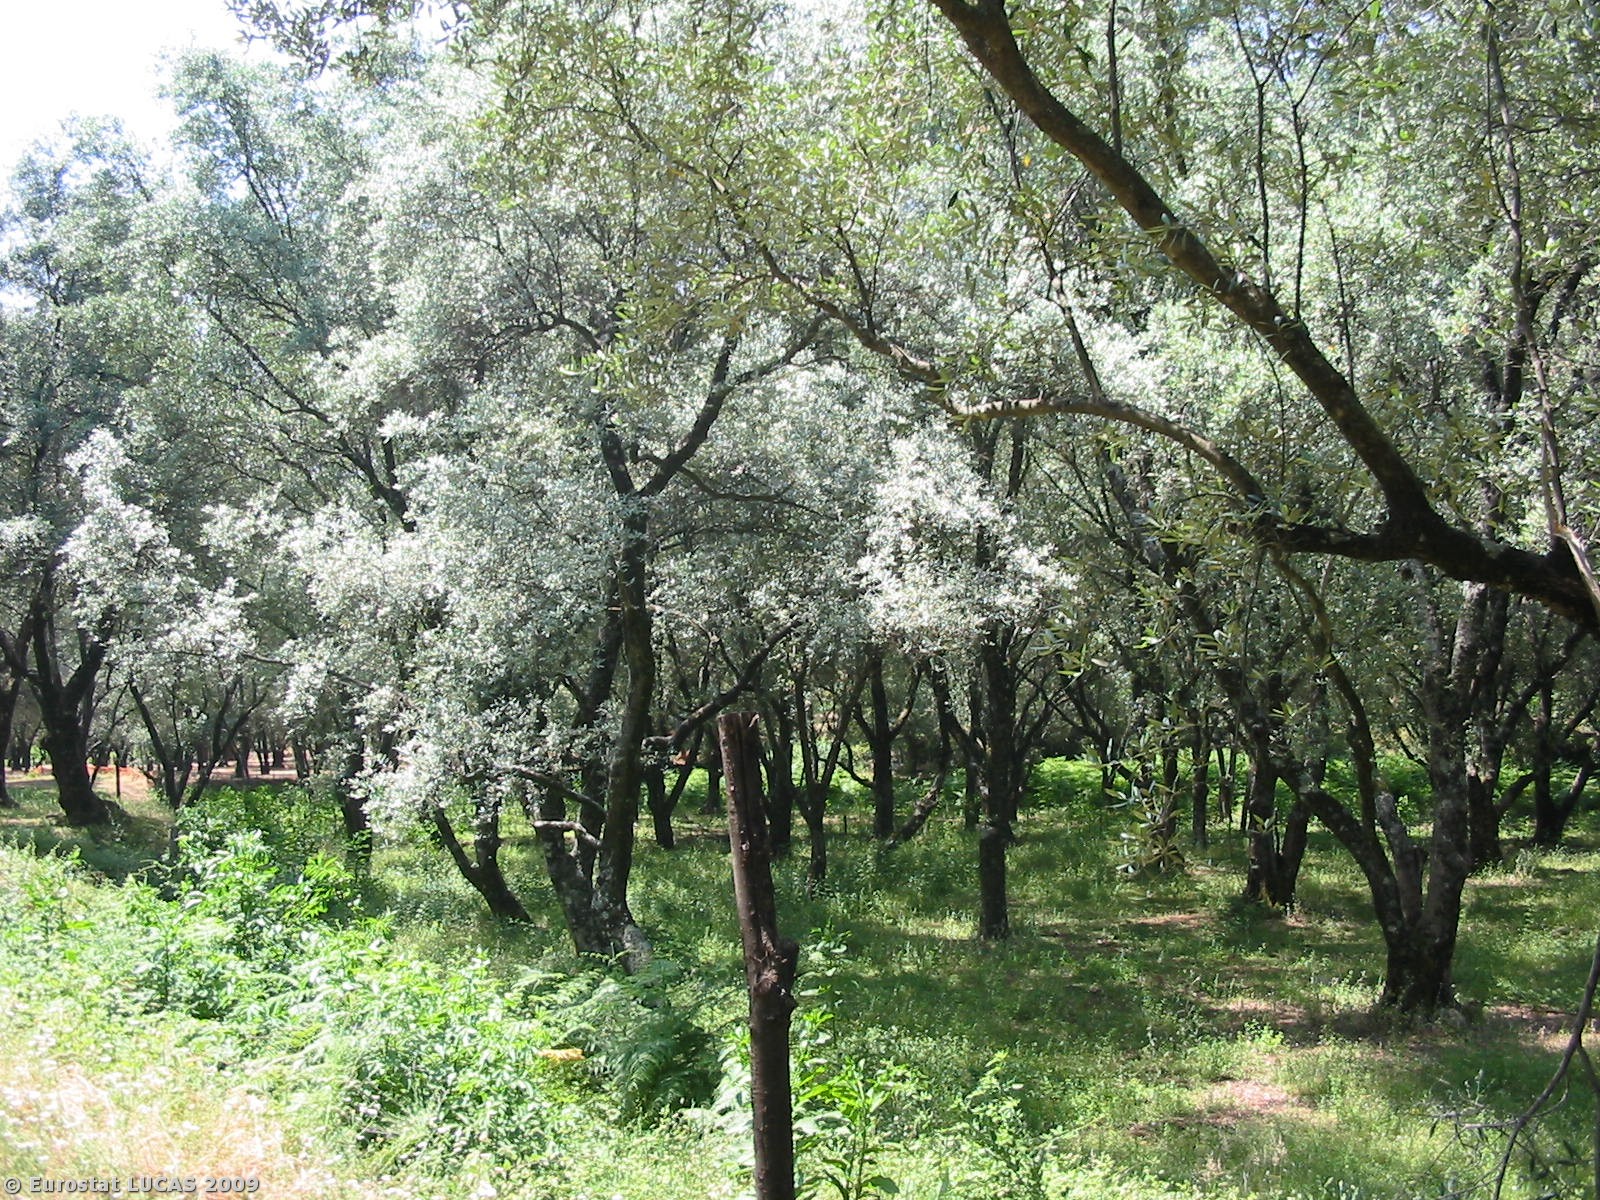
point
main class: Cropland
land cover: Olive groves
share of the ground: 50 - 75 %
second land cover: Spontaneously vegetated surfaces
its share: > 75 %
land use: Agriculture (excluding fallow land and kitchen gardens)
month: June
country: IT
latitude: 38.2542
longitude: 15.9178
